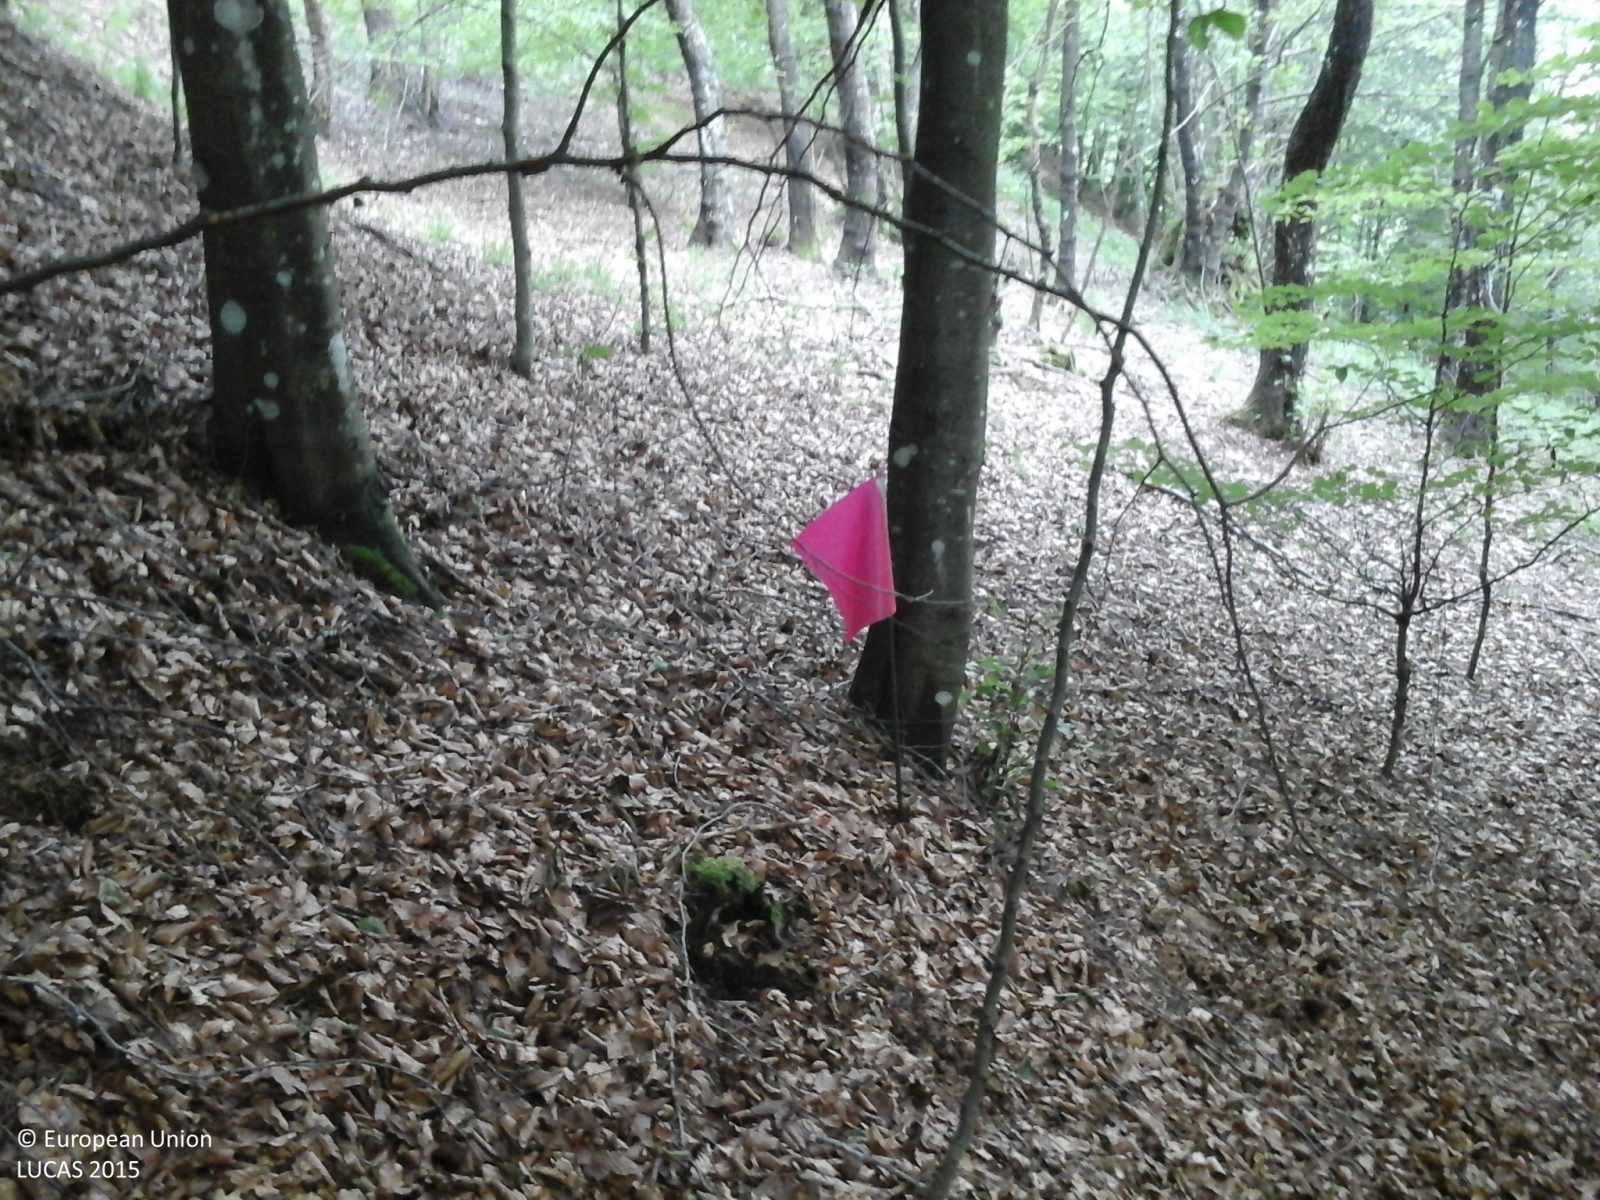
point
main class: Woodland
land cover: Broadleaved woodland
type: mountainous beech forest
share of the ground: > 75 %
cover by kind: broadleaved forest trees 95 %, coniferous forest trees 5 %
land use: Forestry
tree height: > 5 m
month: June
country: IT
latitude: 46.1797
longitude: 12.4195
